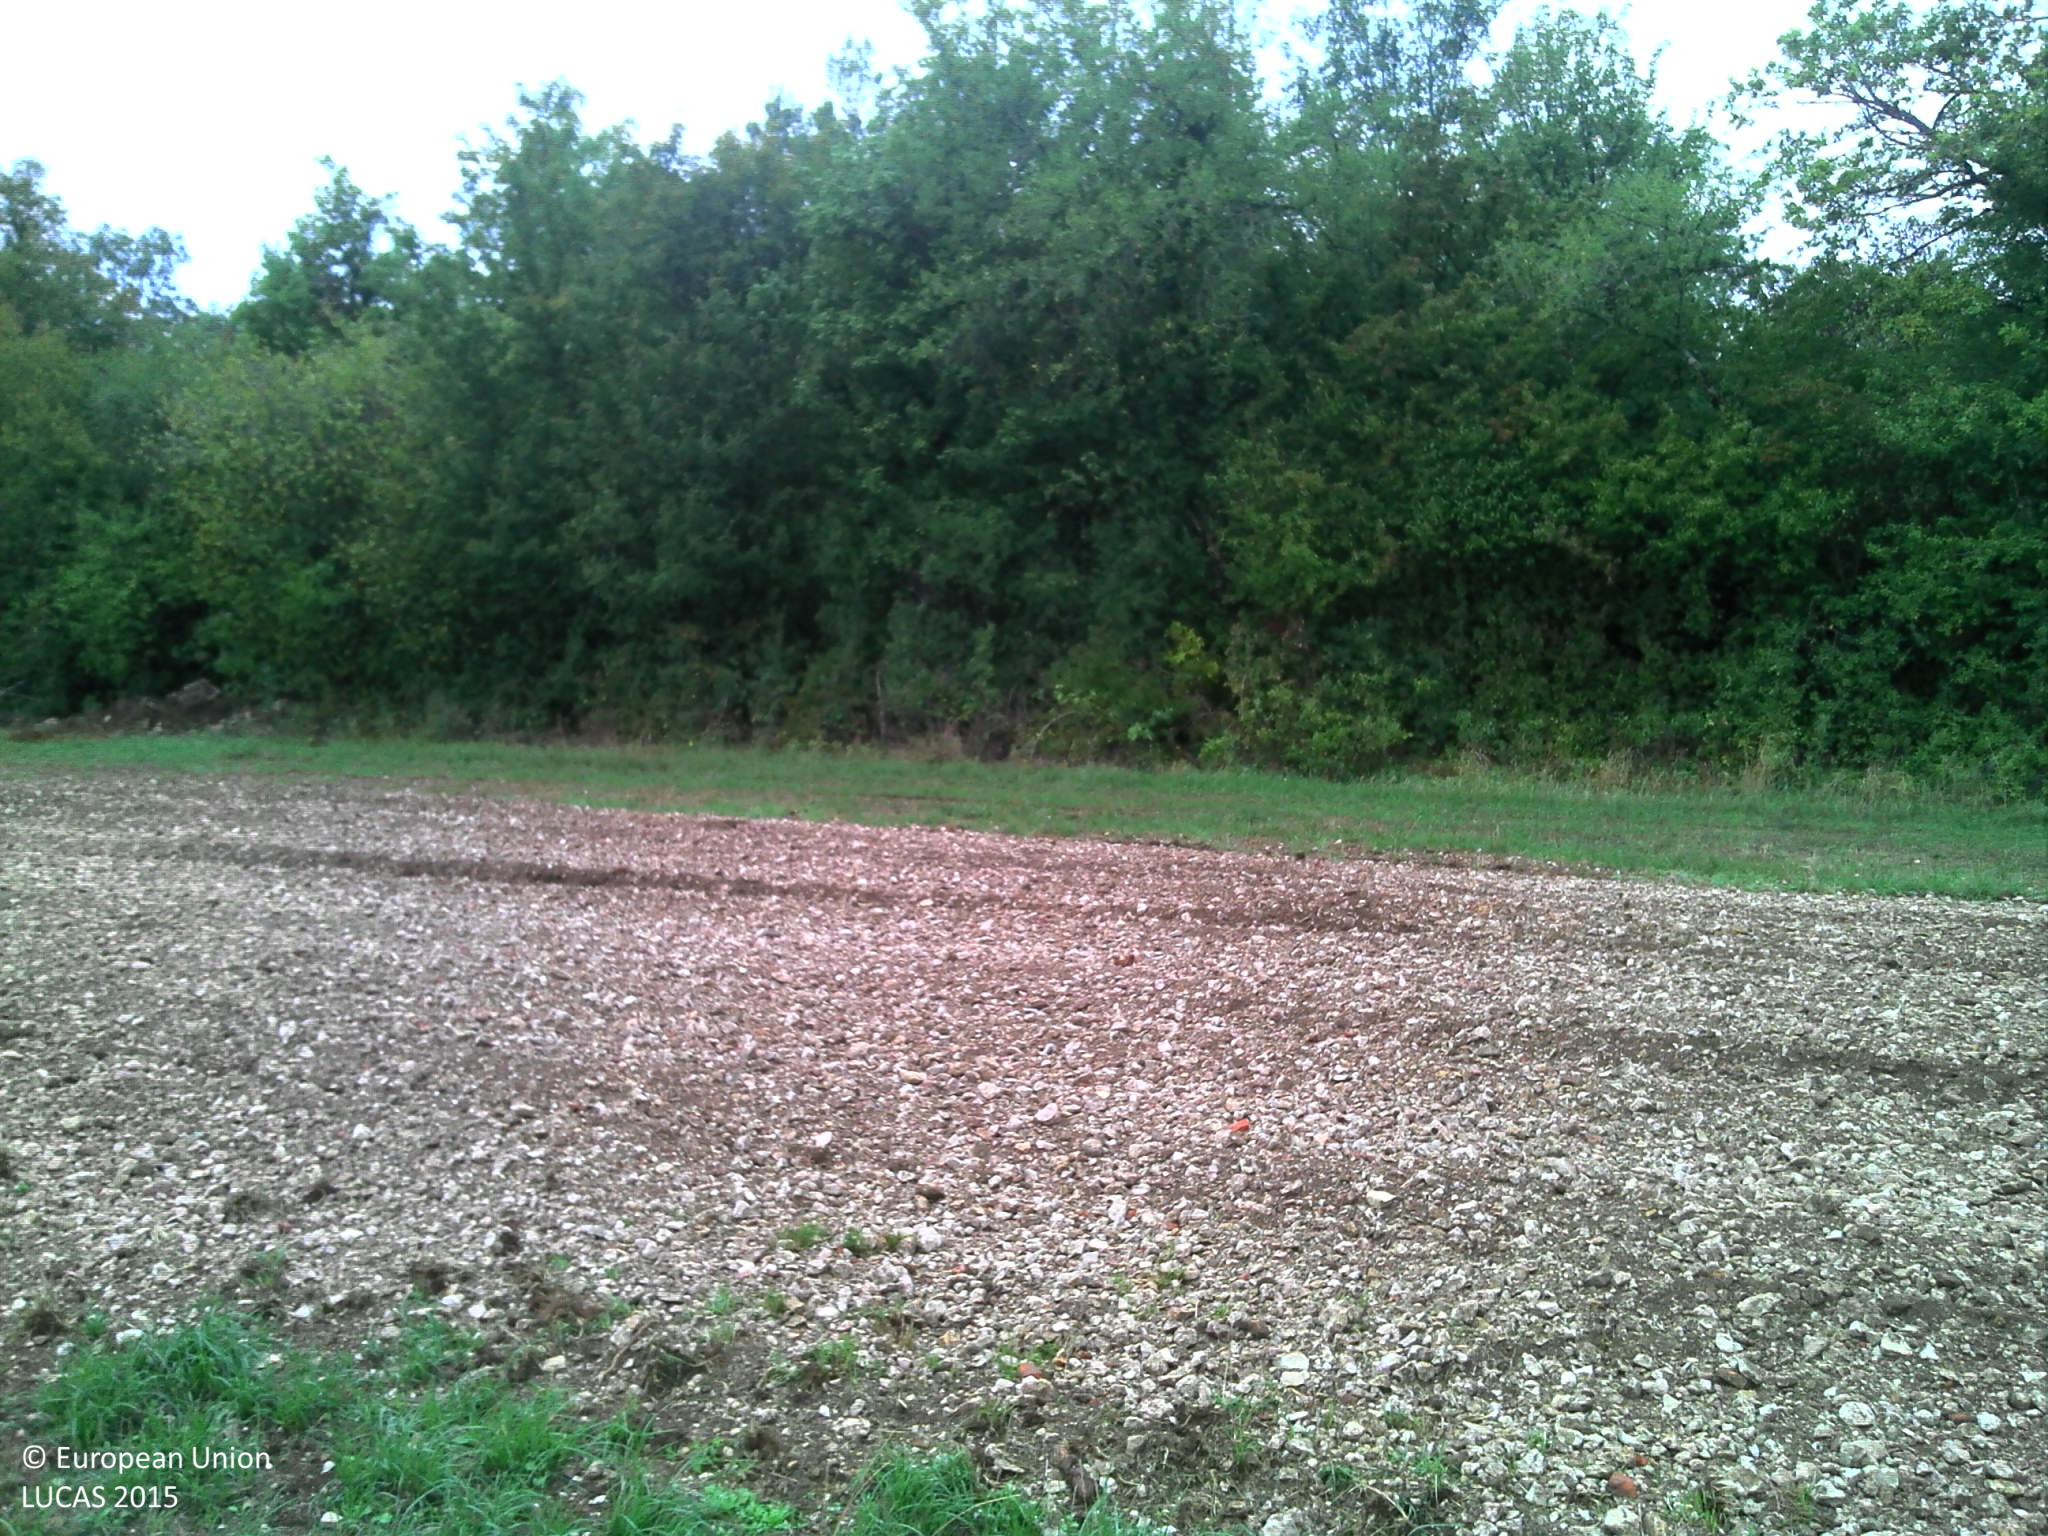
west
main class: Cropland
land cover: Lucerne
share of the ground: 25 - 50 %
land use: Agriculture (excluding fallow land and kitchen gardens)
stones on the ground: < 10 %
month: August
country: FR
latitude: 47.3984
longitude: 4.8193
